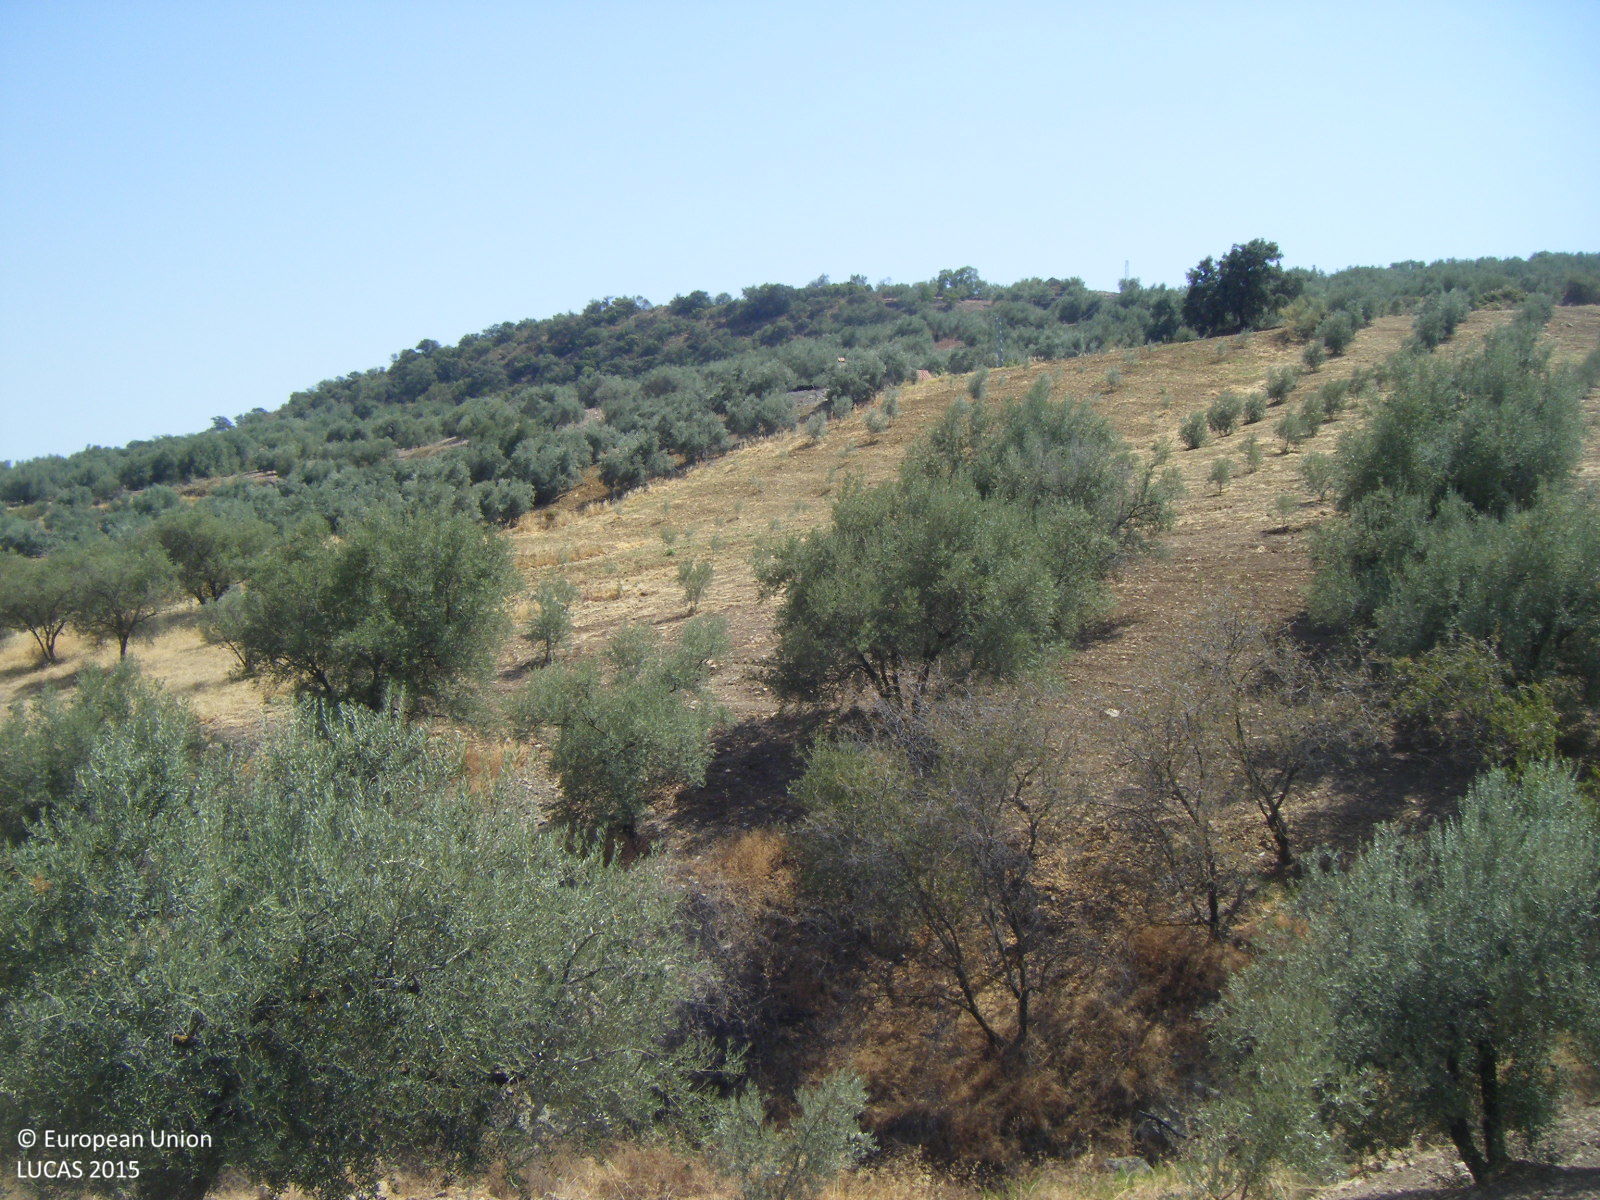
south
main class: Cropland
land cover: Olive groves
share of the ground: 10 - 25 %
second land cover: Other bare soil
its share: > 75 %
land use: Agriculture (excluding fallow land and kitchen gardens)
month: July
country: ES
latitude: 36.8887
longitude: -4.2524
